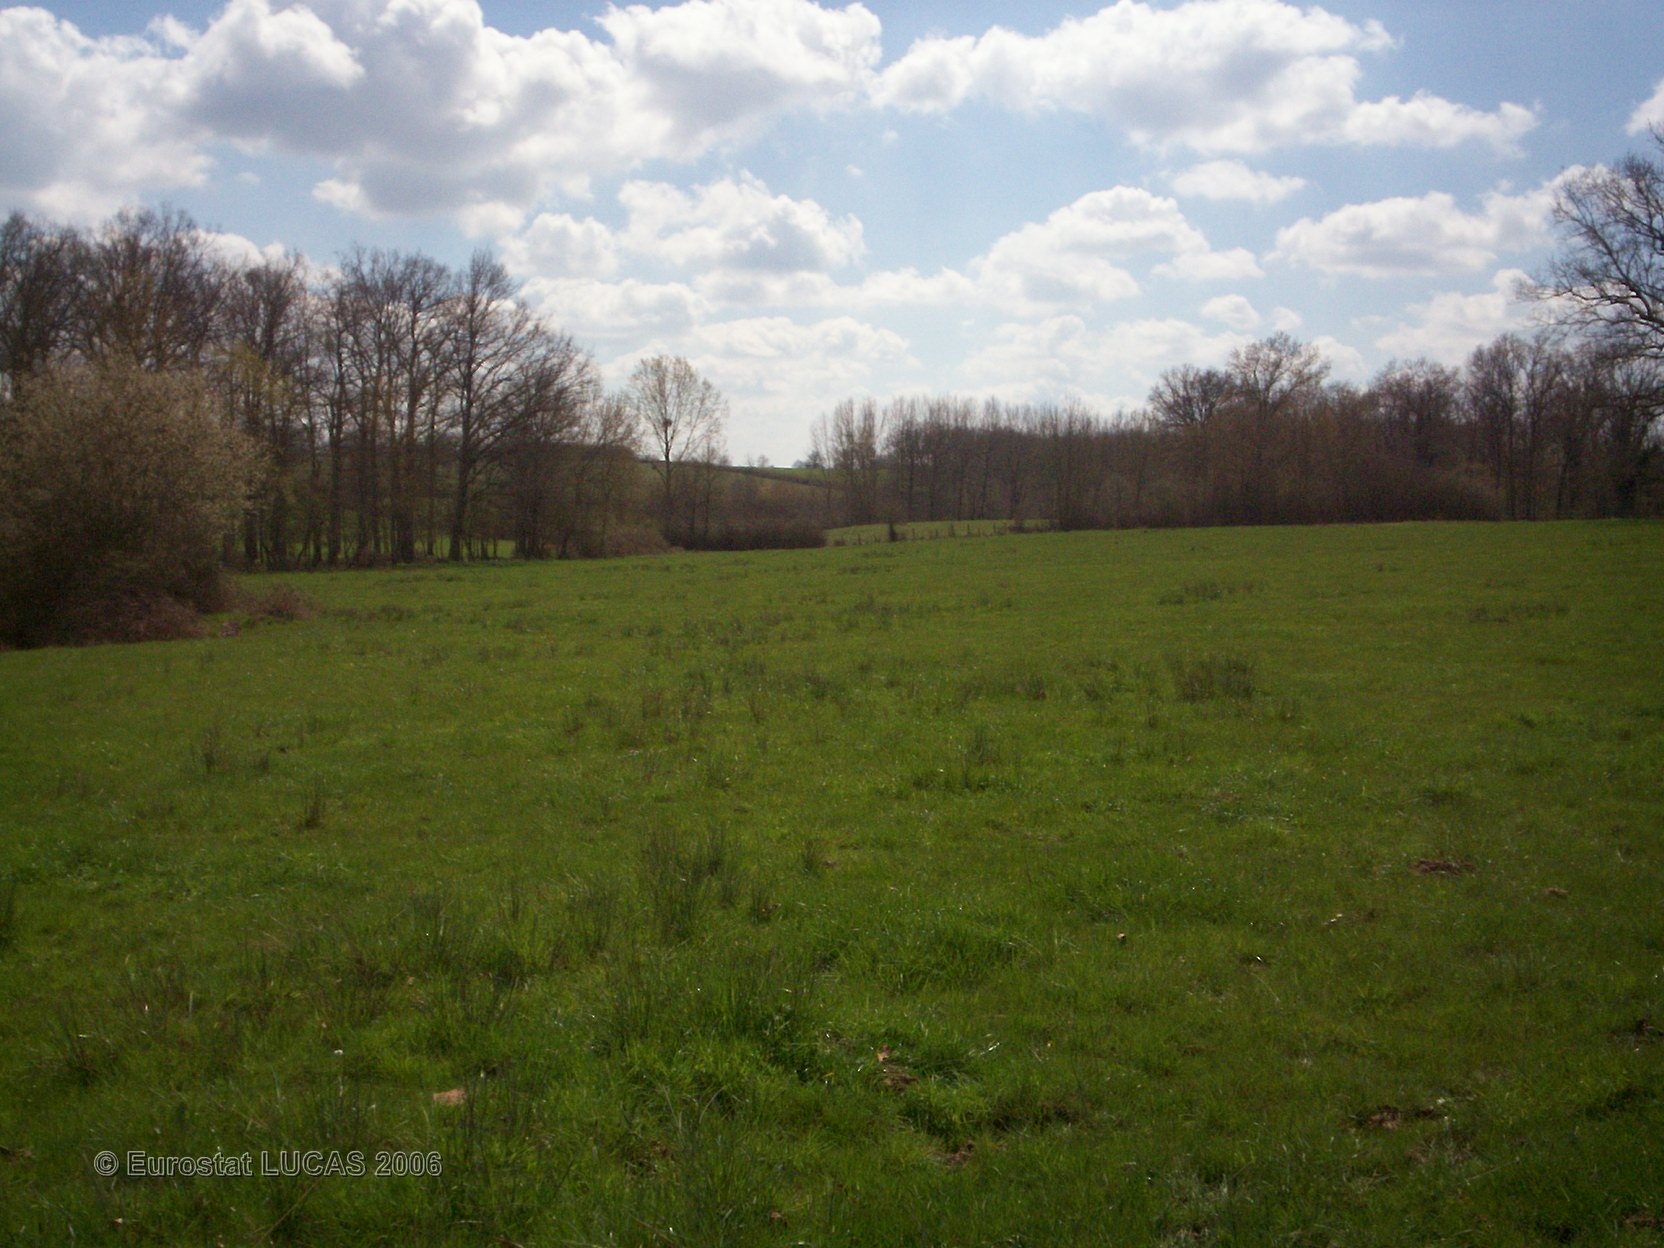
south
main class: Grassland
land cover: Grassland without tree/shrub cover
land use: Agriculture (excluding fallow land and kitchen gardens)
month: April
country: FR
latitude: 46.7606
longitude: 3.0968
